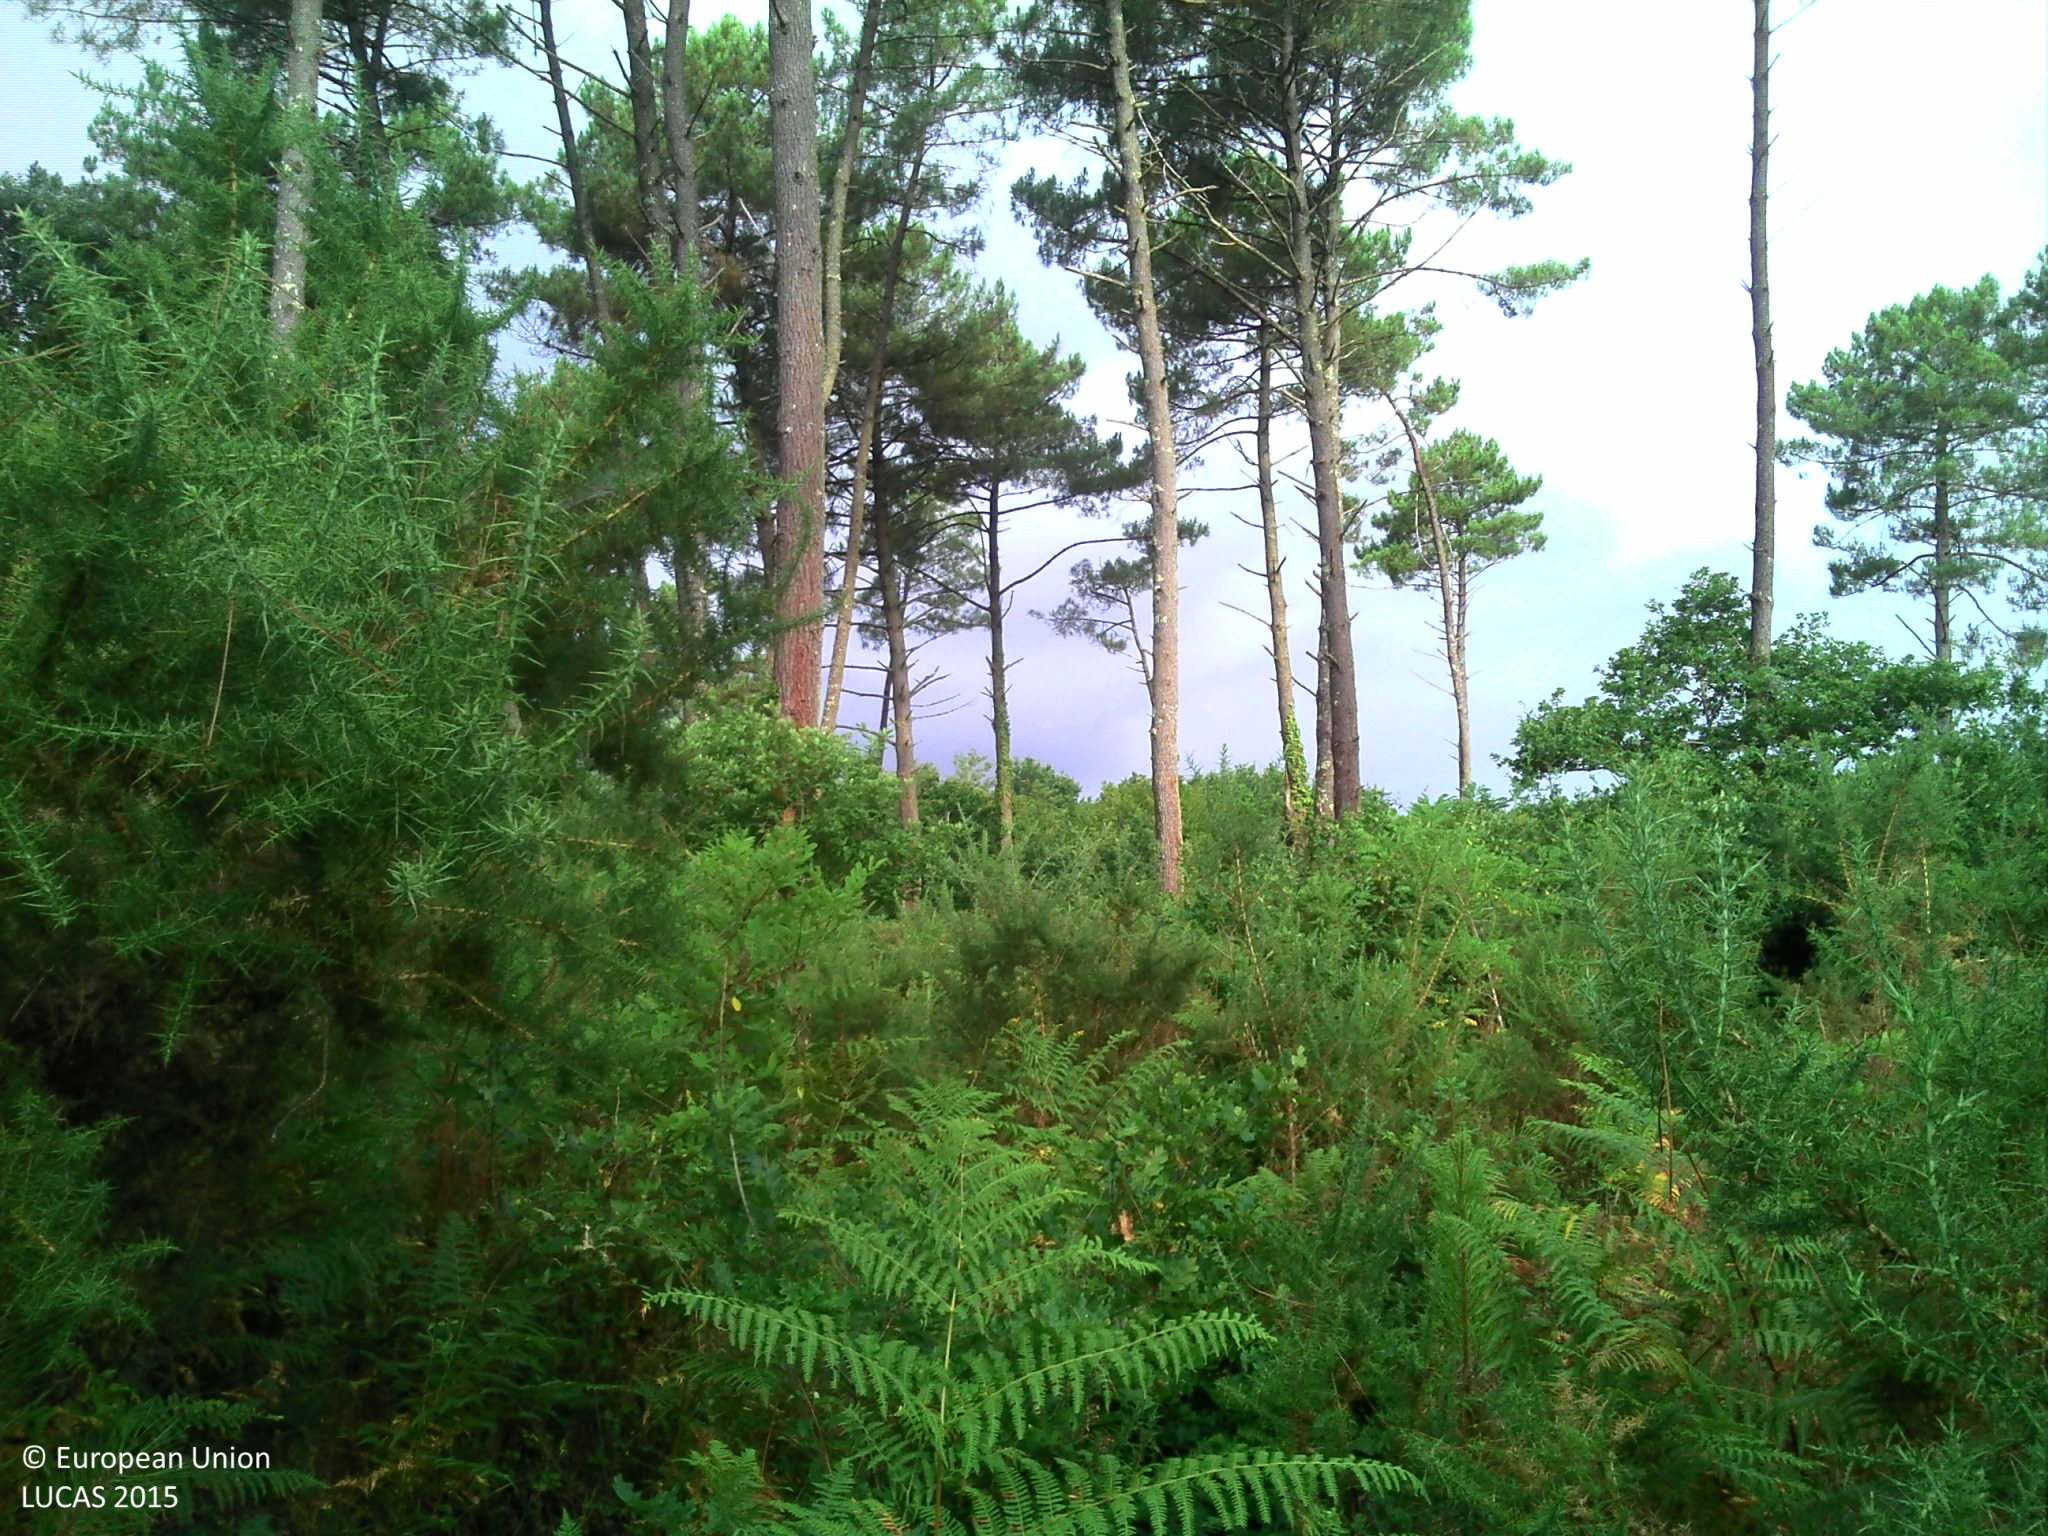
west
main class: Woodland
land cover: Pine dominated mixed woodland
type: coniferous forest of the mediterranean region
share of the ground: > 75 %
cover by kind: coniferous forest trees 50 %, broadleaved forest trees 25 %, herbaceous plants 15 %, shrubs 10 %
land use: Forestry
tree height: > 5 m
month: July
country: FR
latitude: 44.0704
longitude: -1.1943
